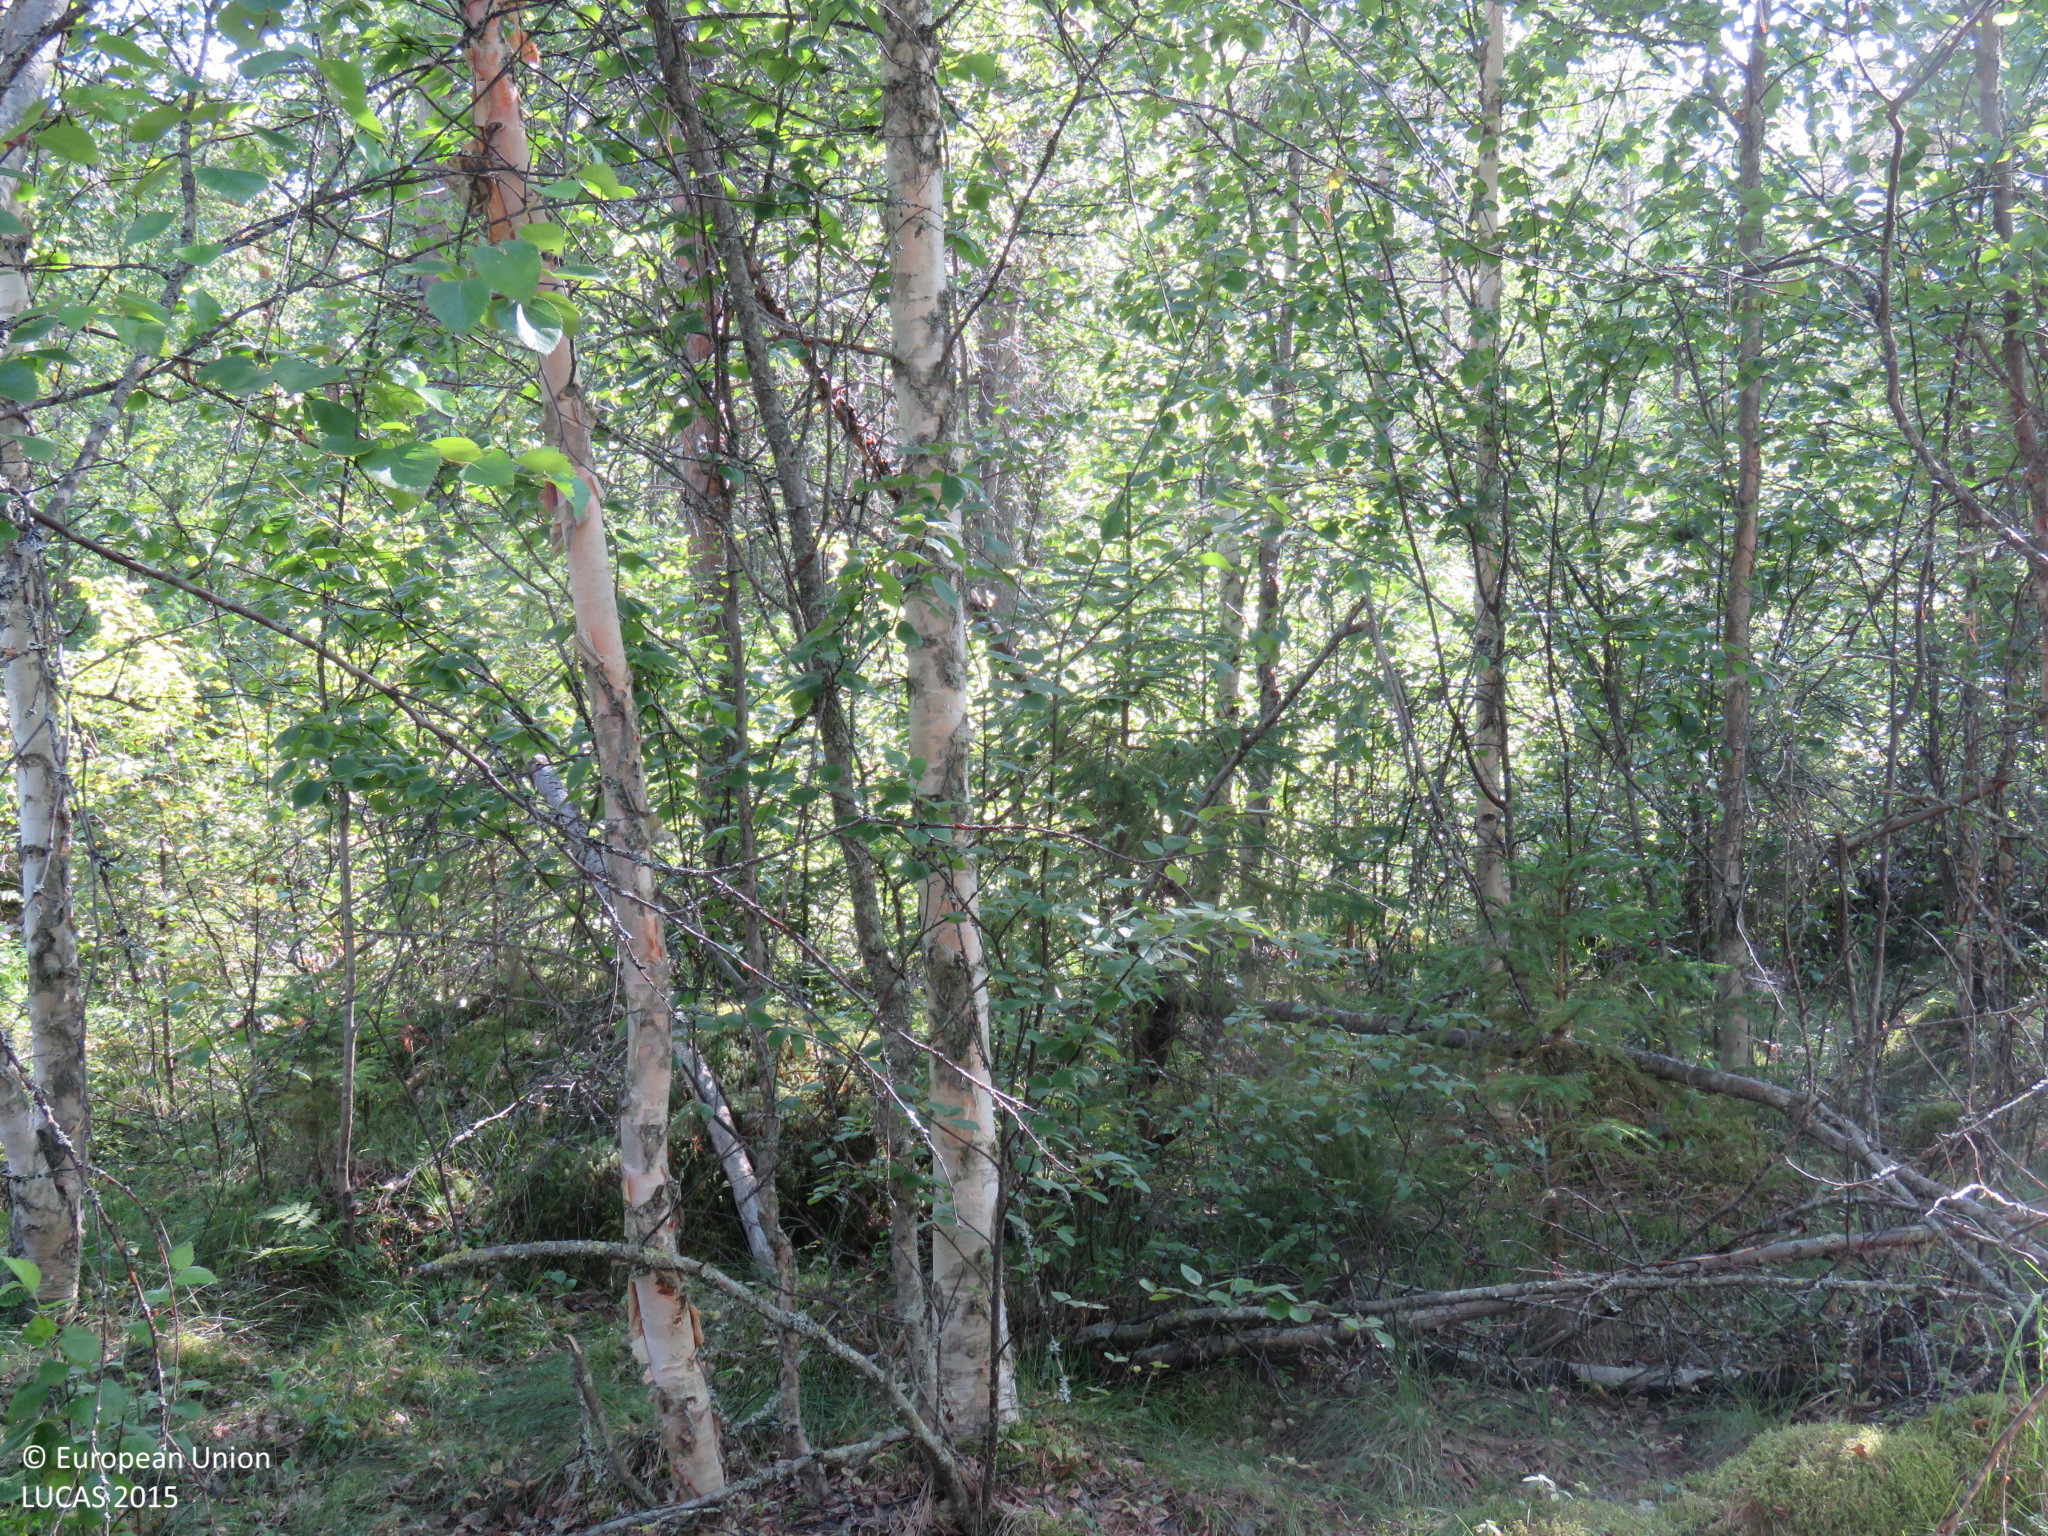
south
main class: Woodland
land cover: Pine dominated mixed woodland
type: mire and swamp forests
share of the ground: > 75 %
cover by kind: broadleaved forest trees 45 %, coniferous forest trees 35 %, herbaceous plants 10 %, shrubs 5 %, lichens and mosses 5 %
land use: Forestry
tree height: > 5 m
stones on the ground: < 10 %
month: July
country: FI
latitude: 64.7243
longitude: 26.2039
